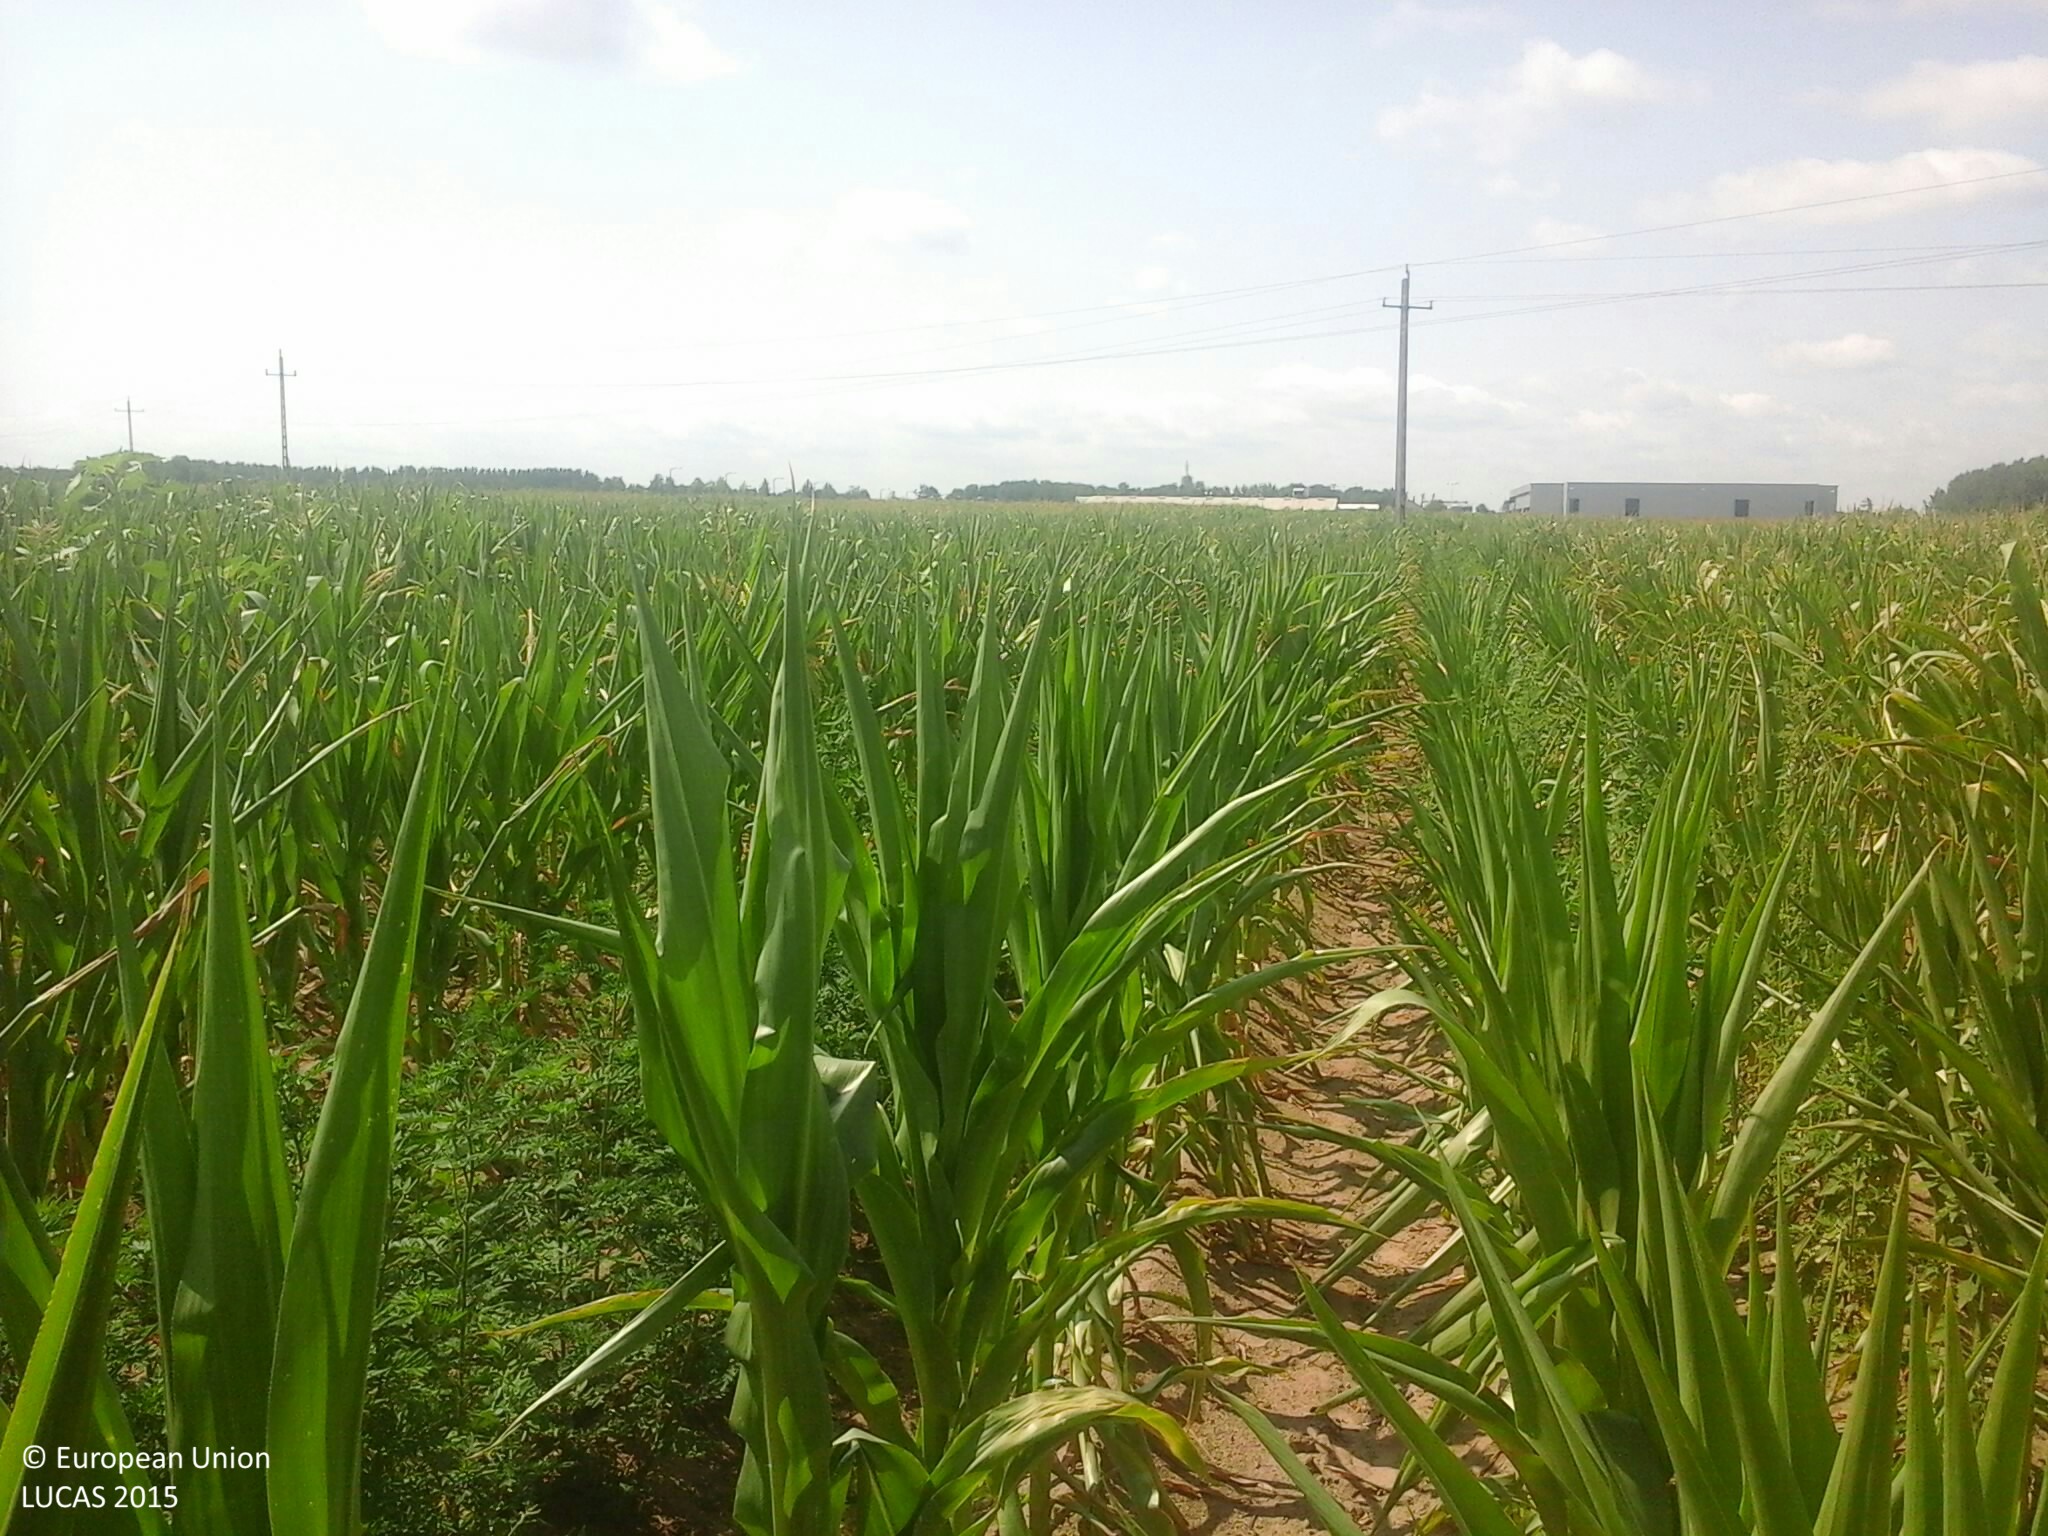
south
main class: Cropland
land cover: Maize
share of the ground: 50 - 75 %
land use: Agriculture (excluding fallow land and kitchen gardens)
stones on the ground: < 10 %
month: July
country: HU
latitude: 47.8580
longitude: 22.1498
